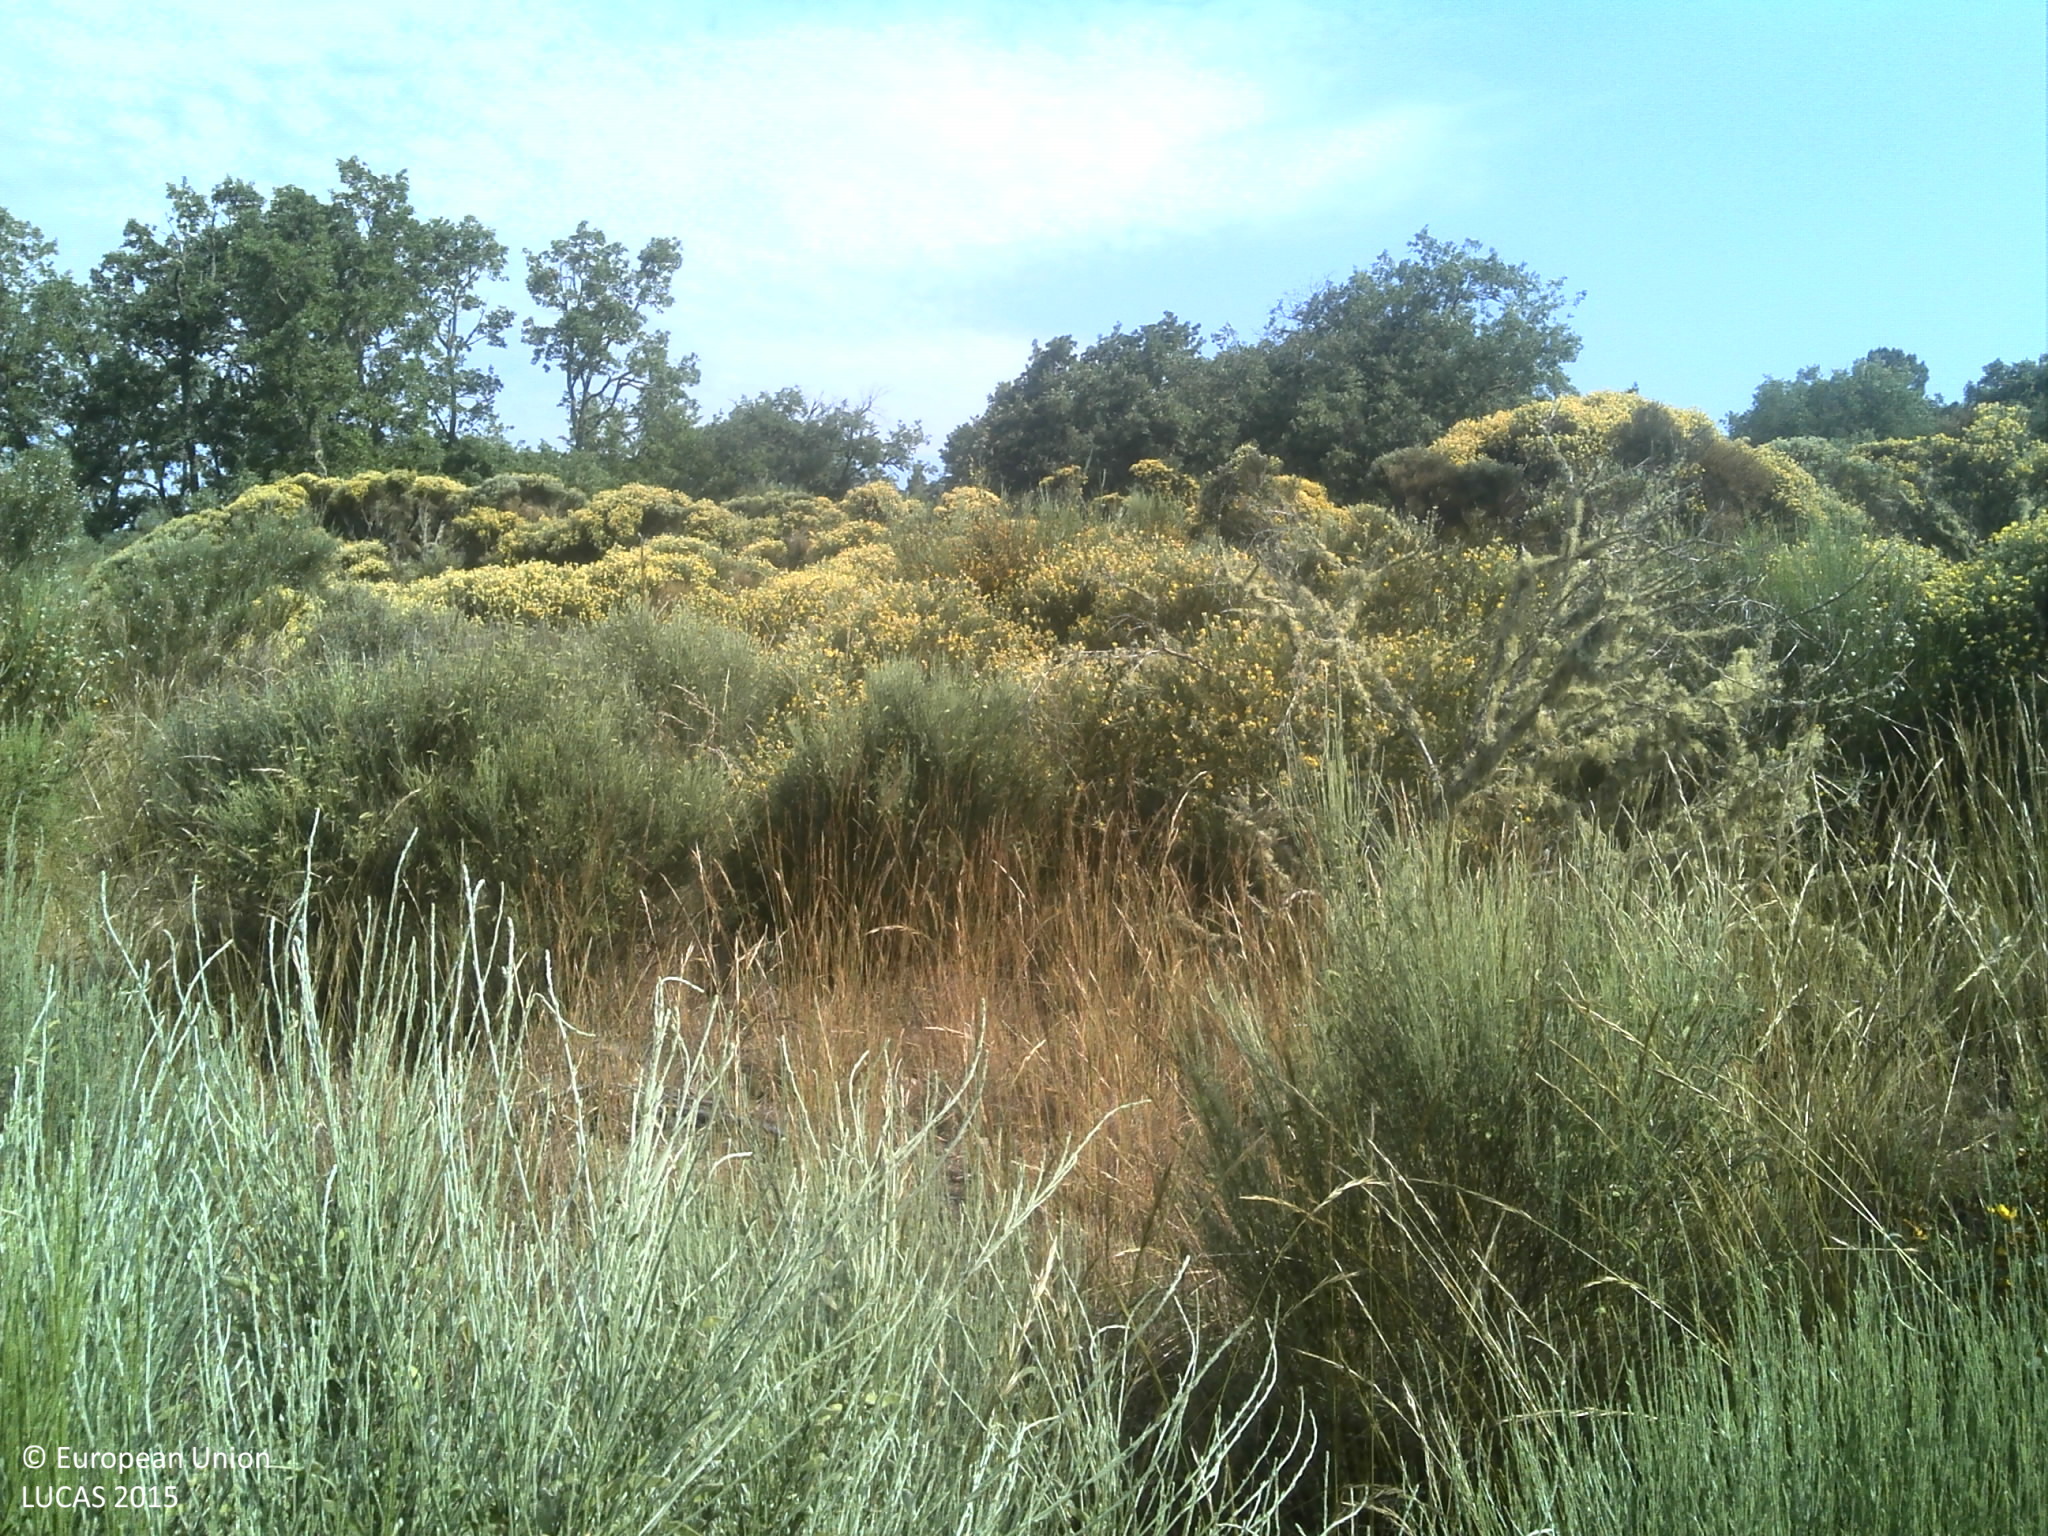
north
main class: Shrubland
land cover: Shrubland with sparse tree cover
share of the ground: 50 - 75 %
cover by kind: shrubs 75 %, unconsolidated bare surface 10 %, broadleaved forest trees 5 %
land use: Abandoned areas
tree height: < 5 m
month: June
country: PT
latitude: 40.5745
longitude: -7.1253
